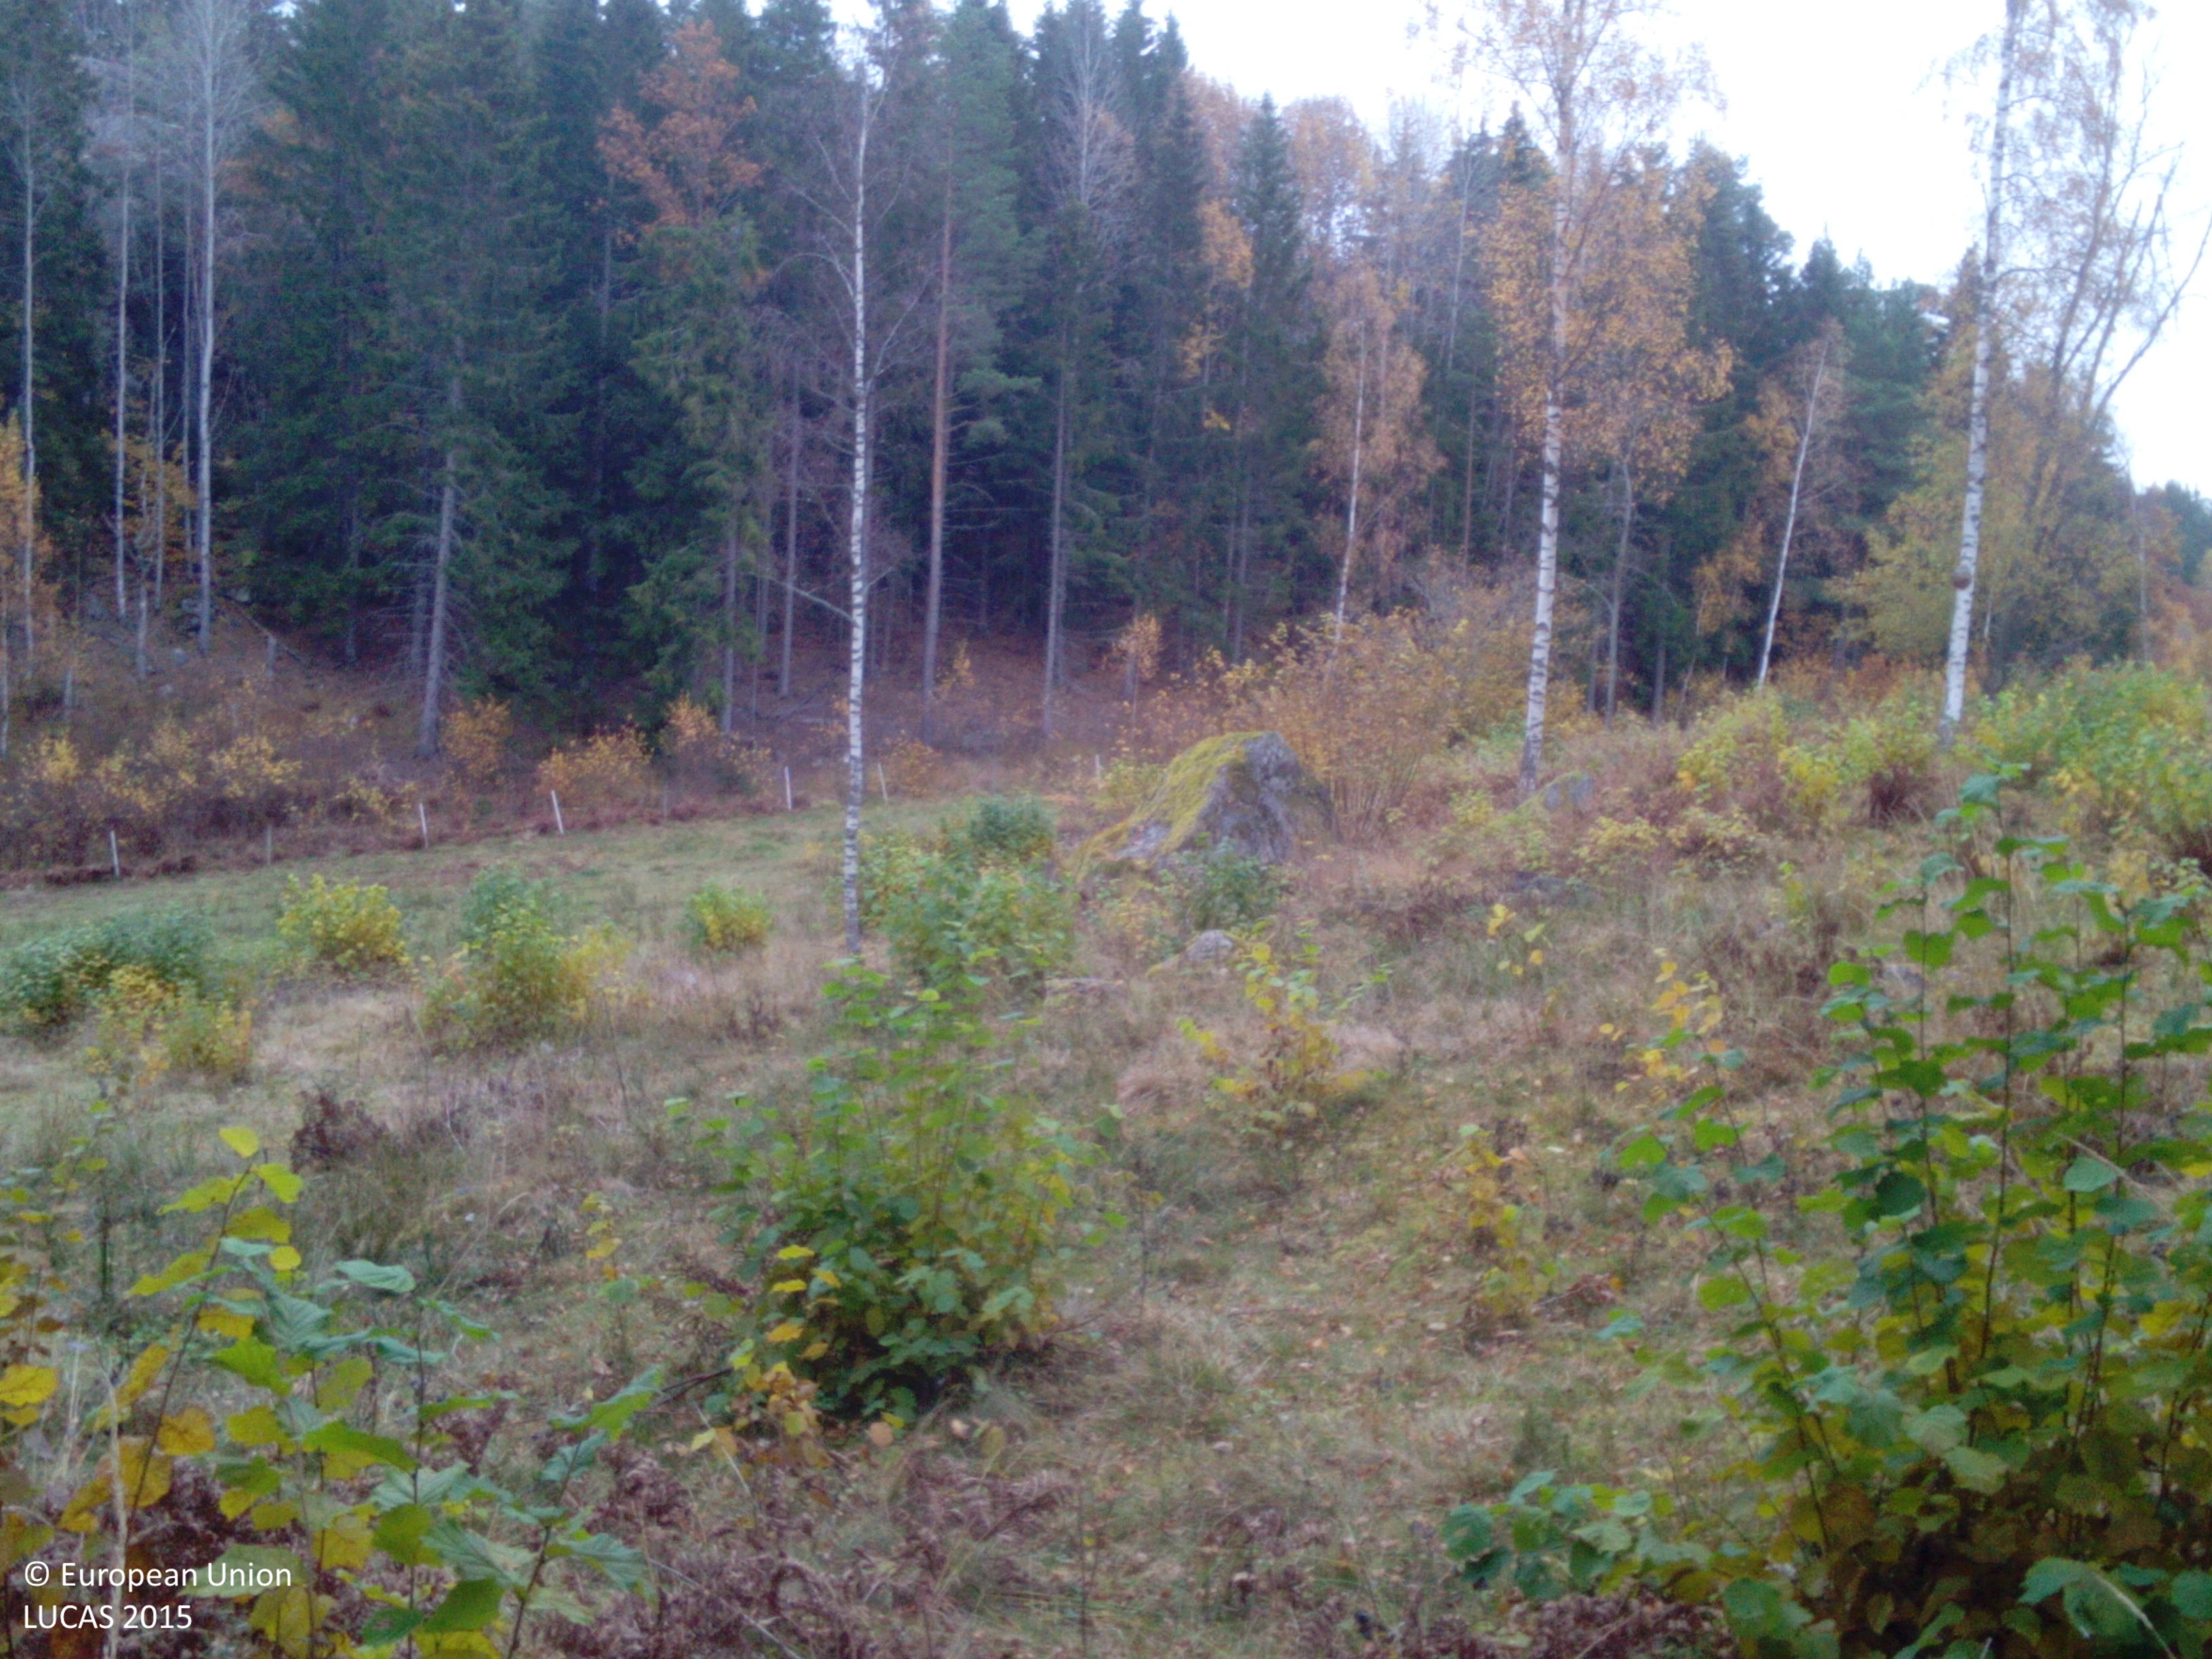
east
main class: Woodland
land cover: Broadleaved woodland
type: hemiboreal forest and nemoral coniferous forest and mixed broadleaved-coniferous forest
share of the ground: 25 - 50 %
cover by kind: herbaceous plants 60 %, broadleaved forest trees 40 %
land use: Agriculture (excluding fallow land and kitchen gardens)
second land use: Forestry
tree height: > 5 m
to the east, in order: Broadleaved woodland; Grassland with sparse tree/shrub cover; Shrubland with sparse tree cover; Grassland without tree/shrub cover; Fences; Ditches and canals; Spruce dominated coniferous woodland; Broadleaved woodland; Rock outcrops; Lichens and moss; Grassland with sparse tree/shrub cover; Broadleaved woodland; Grassland with sparse tree/shrub cover; Grassland without tree/shrub cover
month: October
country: SE
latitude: 58.9985
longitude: 16.5568
